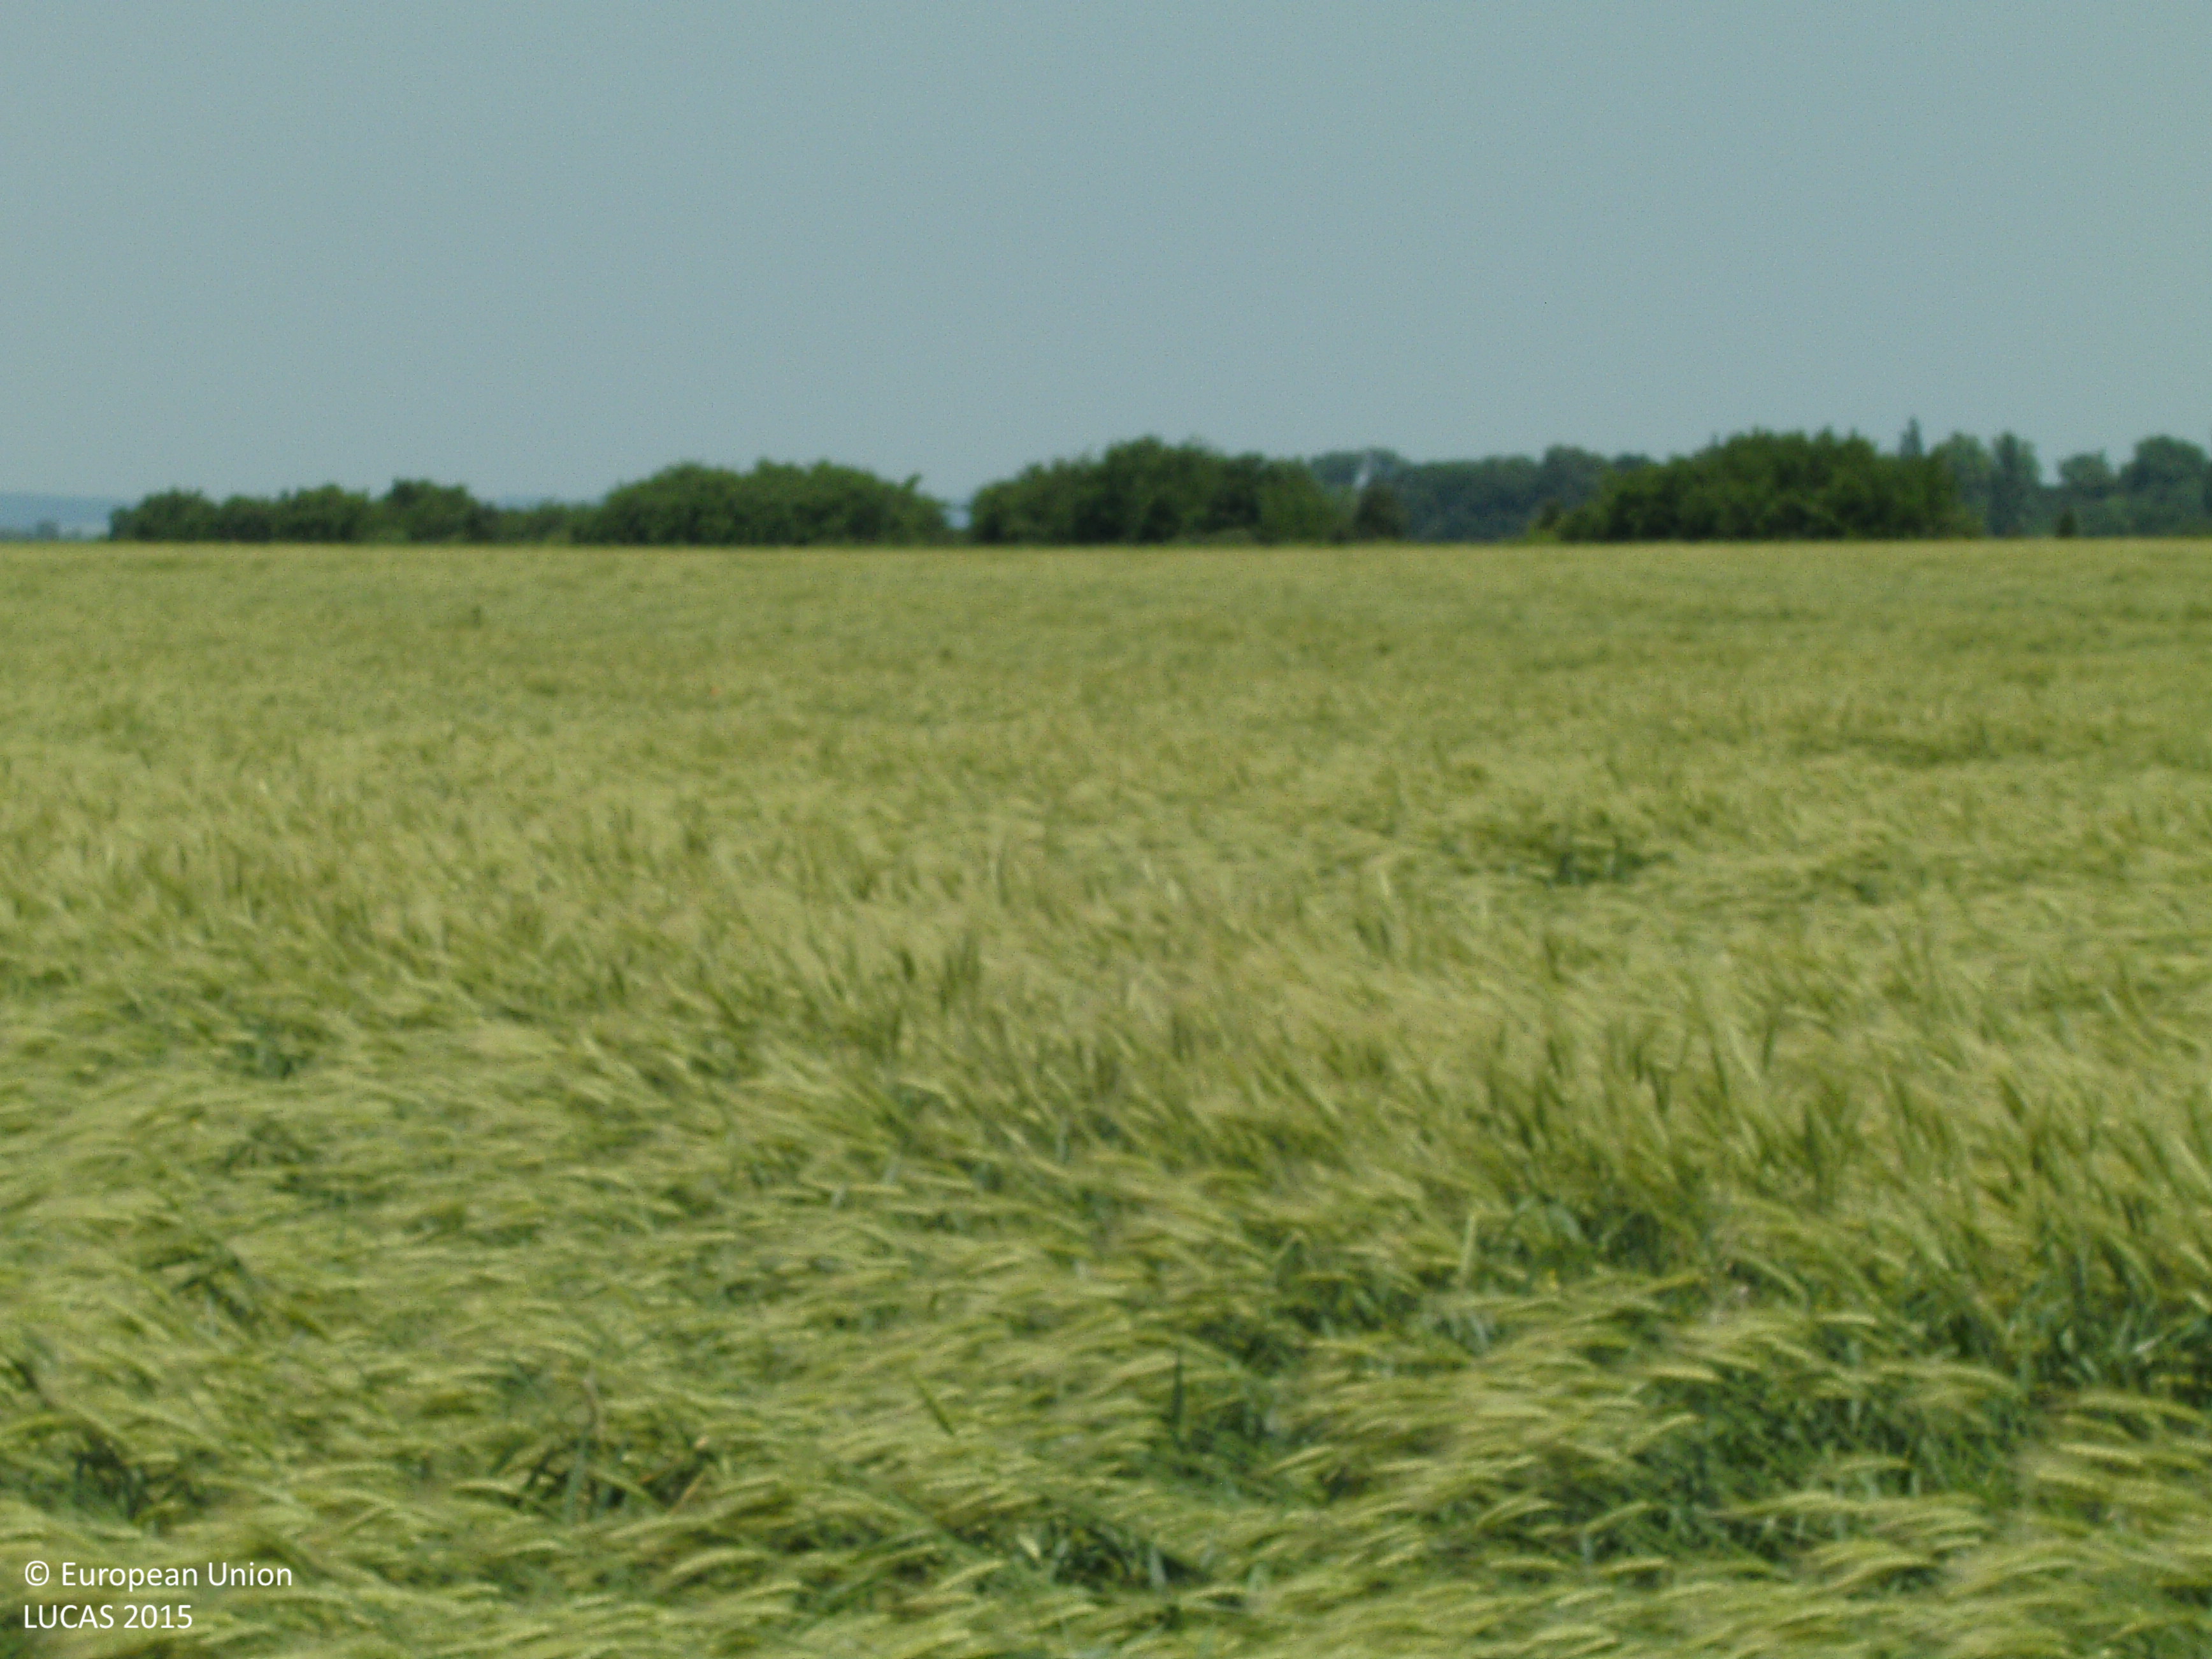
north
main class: Cropland
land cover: Common wheat
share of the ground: > 75 %
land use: Agriculture (excluding fallow land and kitchen gardens)
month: June
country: HU
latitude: 46.3787
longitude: 17.9767
